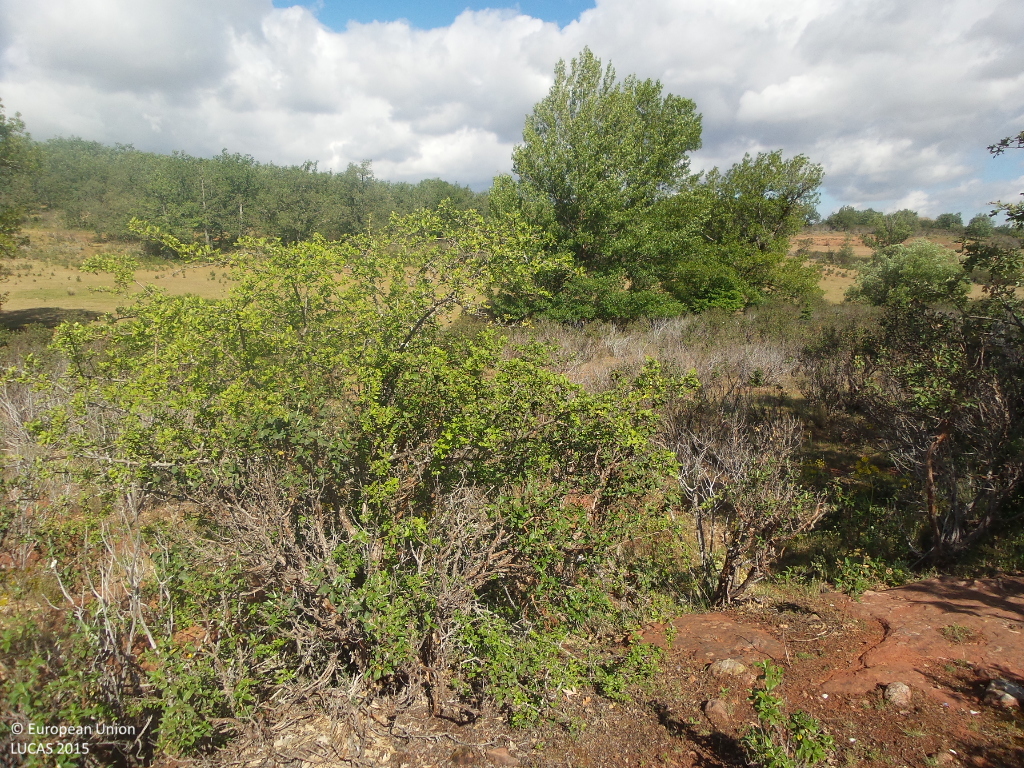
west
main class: Shrubland
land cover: Shrubland with sparse tree cover
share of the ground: 50 - 75 %
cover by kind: shrubs 50 %, consolidated bare surface 30 %, lichens and mosses 10 %, broadleaved forest trees 5 %, unconsolidated bare surface 5 %
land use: Semi-natural and natural areas not in use
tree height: > 5 m
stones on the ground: 25 - 50 %
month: June
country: ES
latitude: 41.2947
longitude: -3.0444
